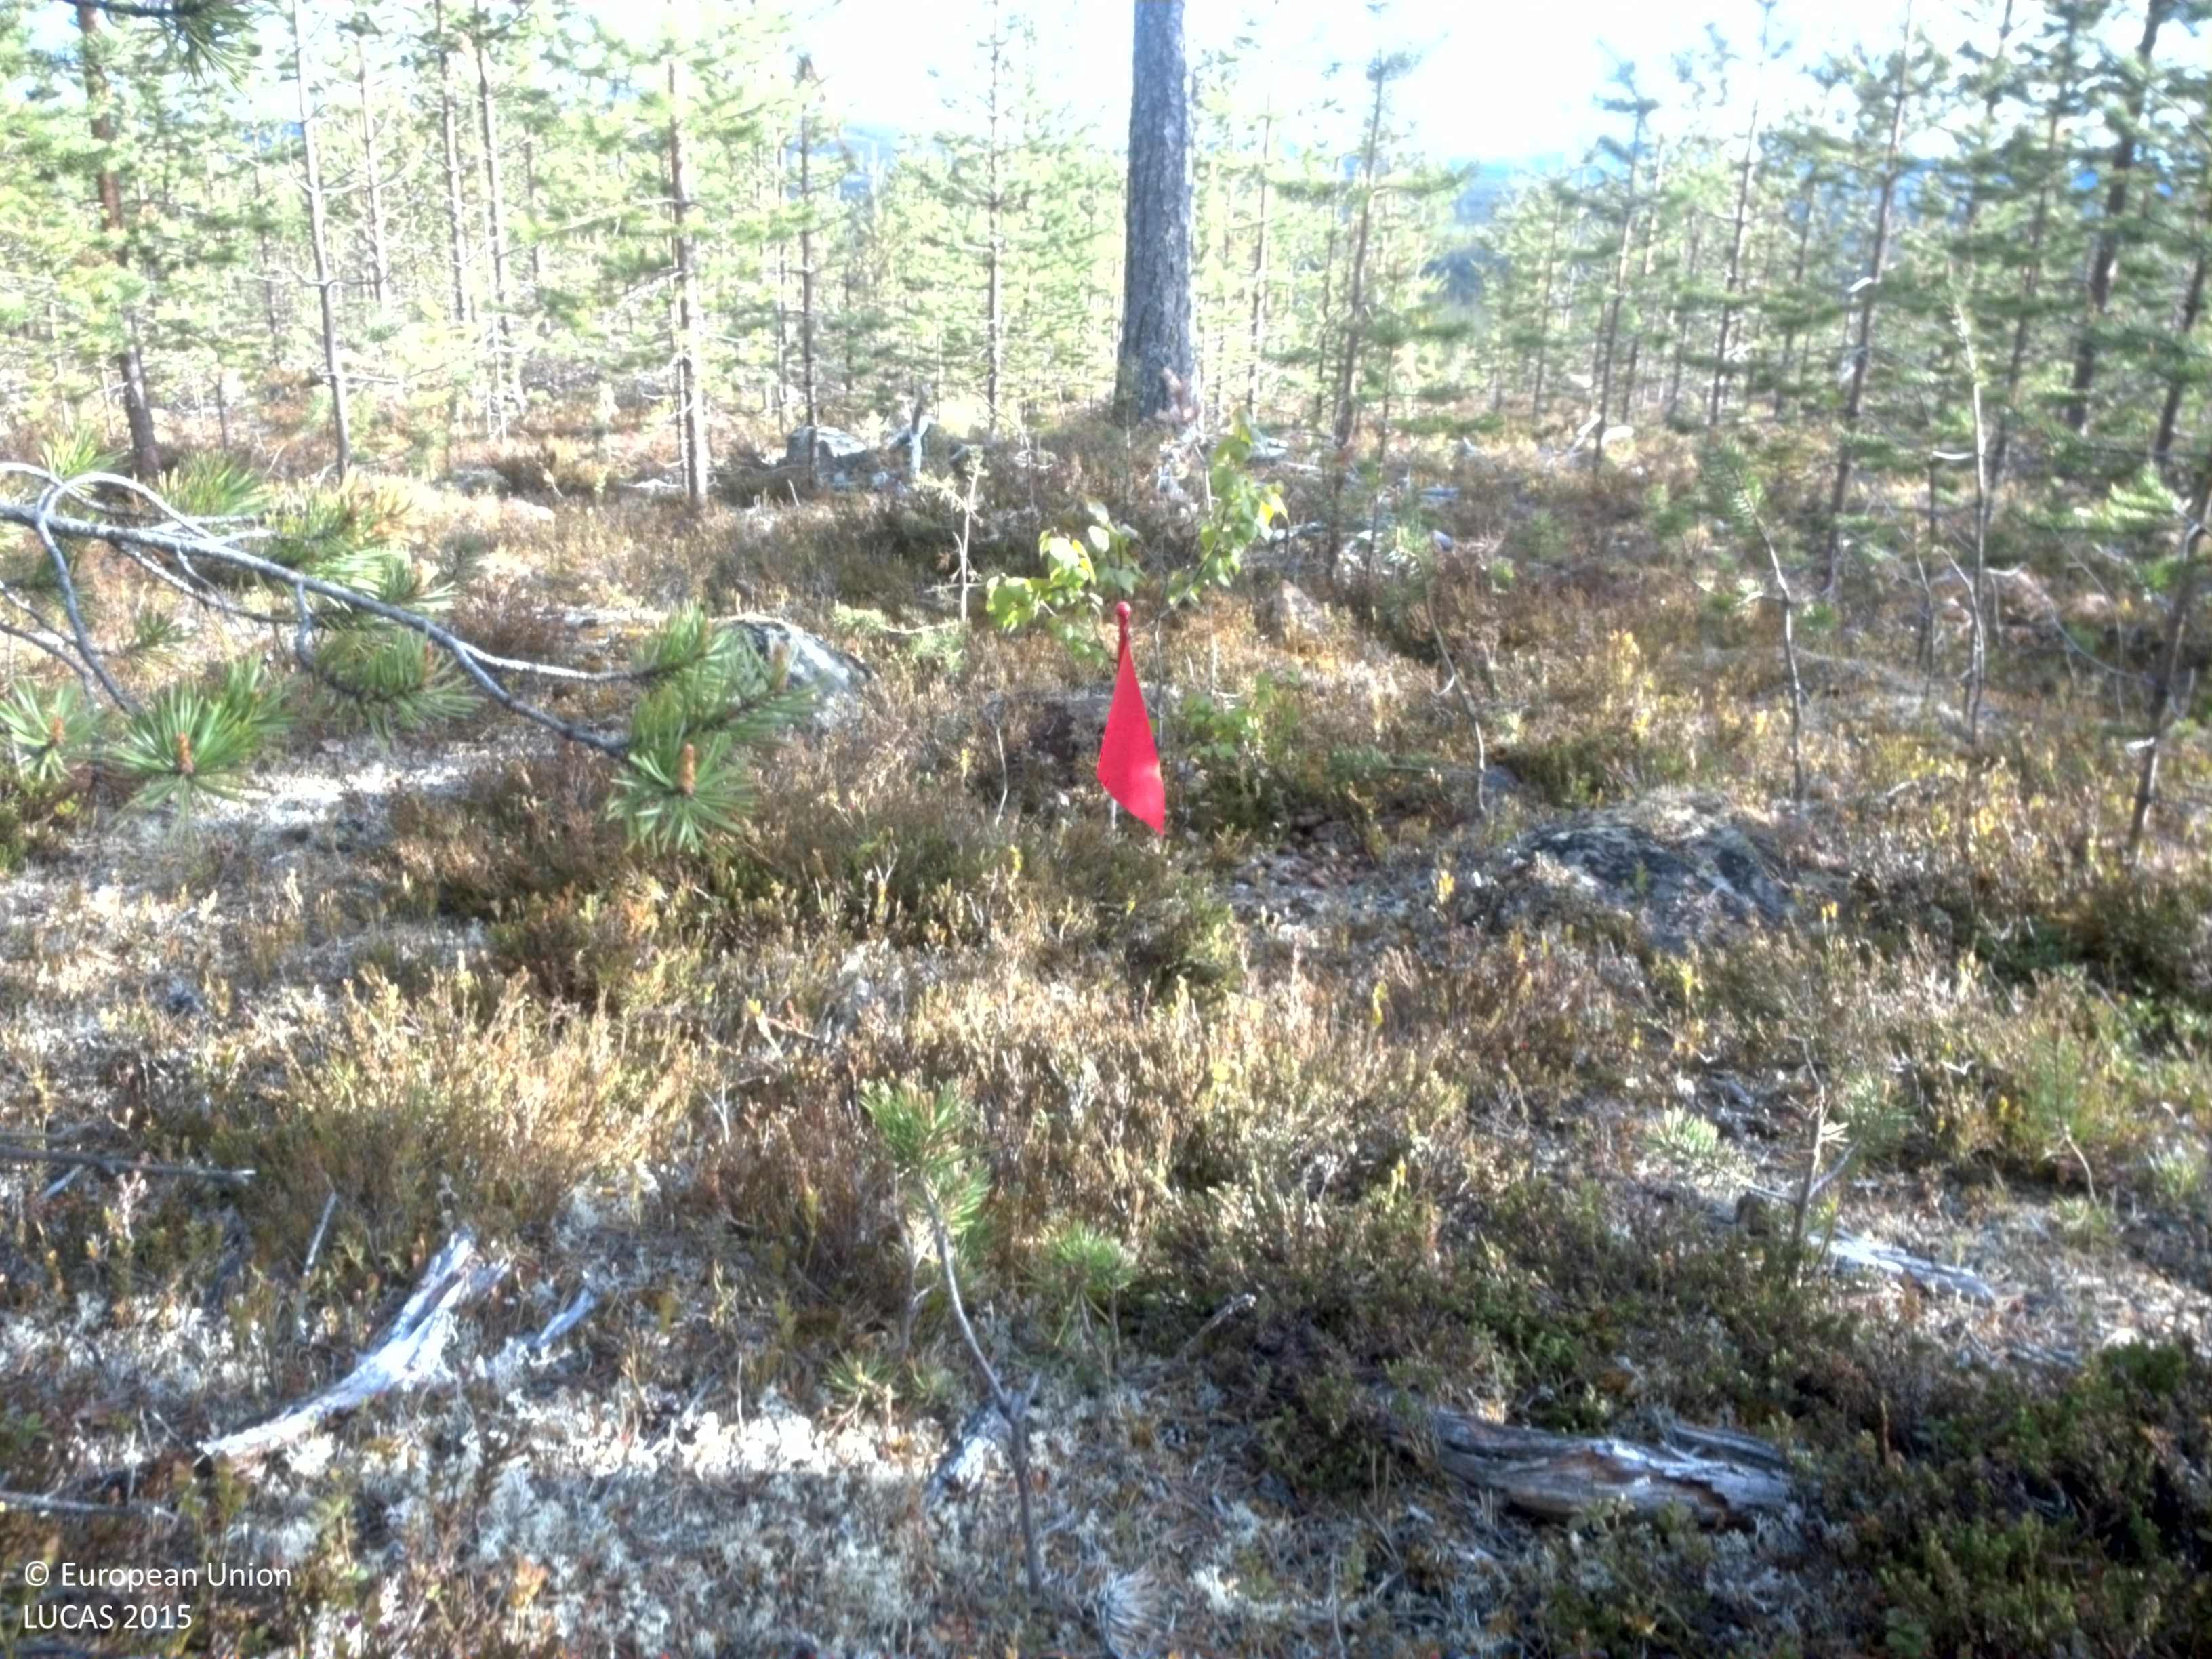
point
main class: Woodland
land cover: Pine dominated coniferous woodland
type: boreal forest
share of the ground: 25 - 50 %
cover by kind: shrubs 45 %, coniferous forest trees 40 %, lichens and mosses 15 %
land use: Forestry
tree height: > 5 m
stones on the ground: 10 - 25 %
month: June
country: SE
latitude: 66.9114
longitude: 22.0041
